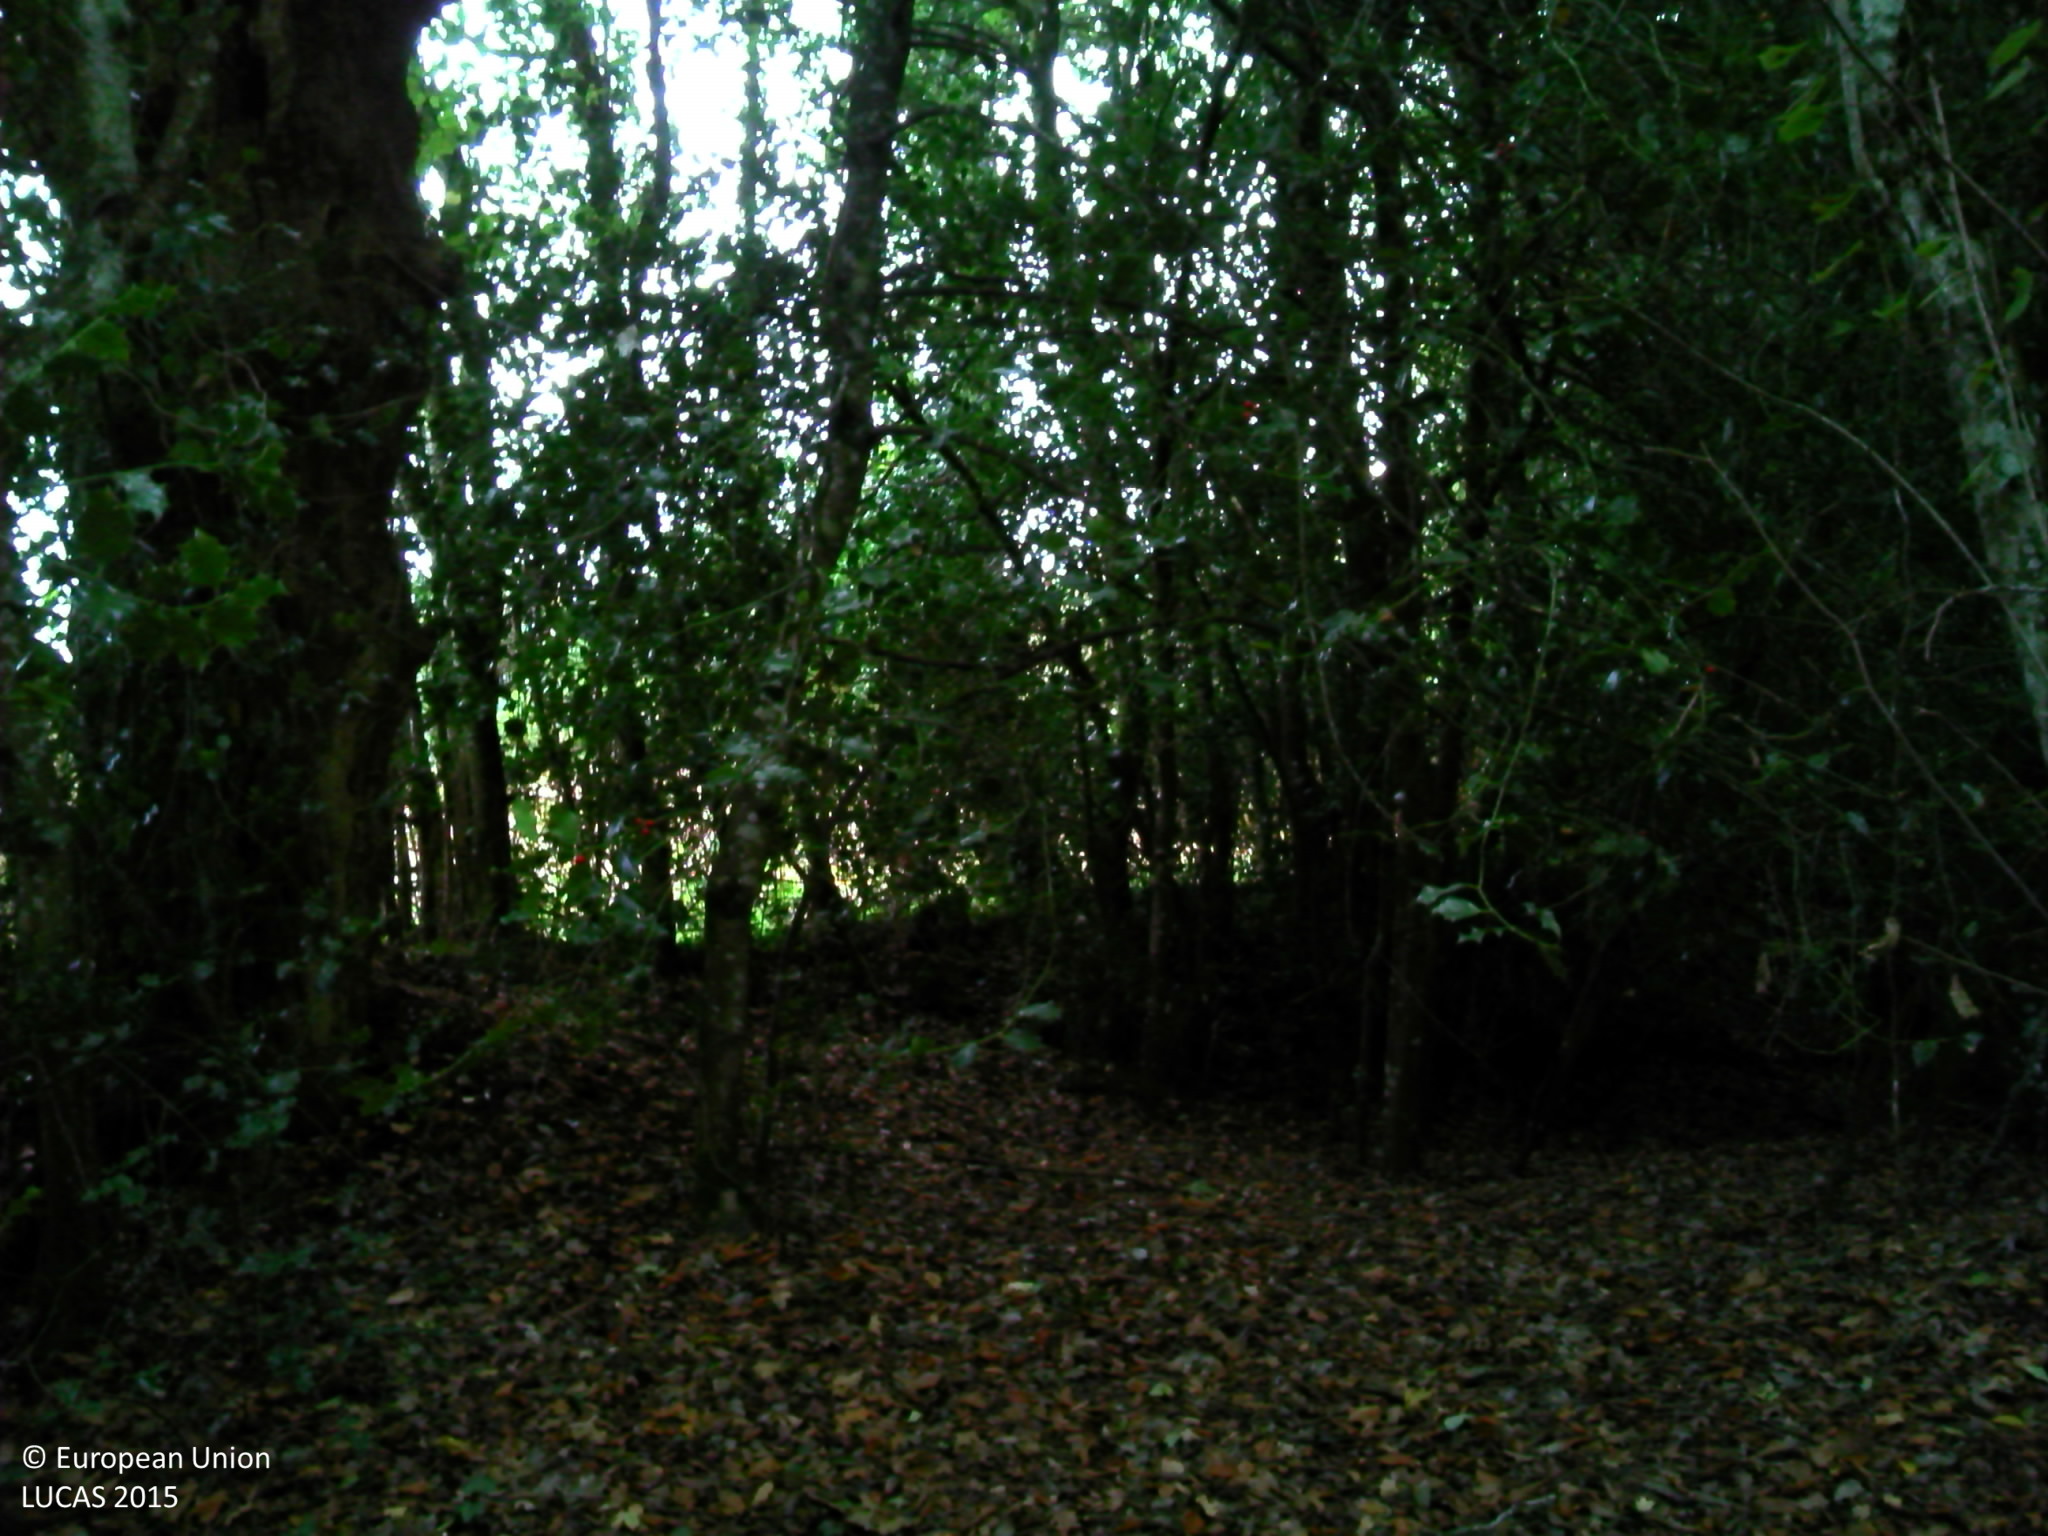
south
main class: Woodland
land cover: Broadleaved woodland
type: beech forest
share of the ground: > 75 %
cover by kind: broadleaved forest trees 85 %, herbaceous plants 15 %
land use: Forestry
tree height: > 5 m
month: October
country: FR
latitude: 45.9124
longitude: 2.8433
